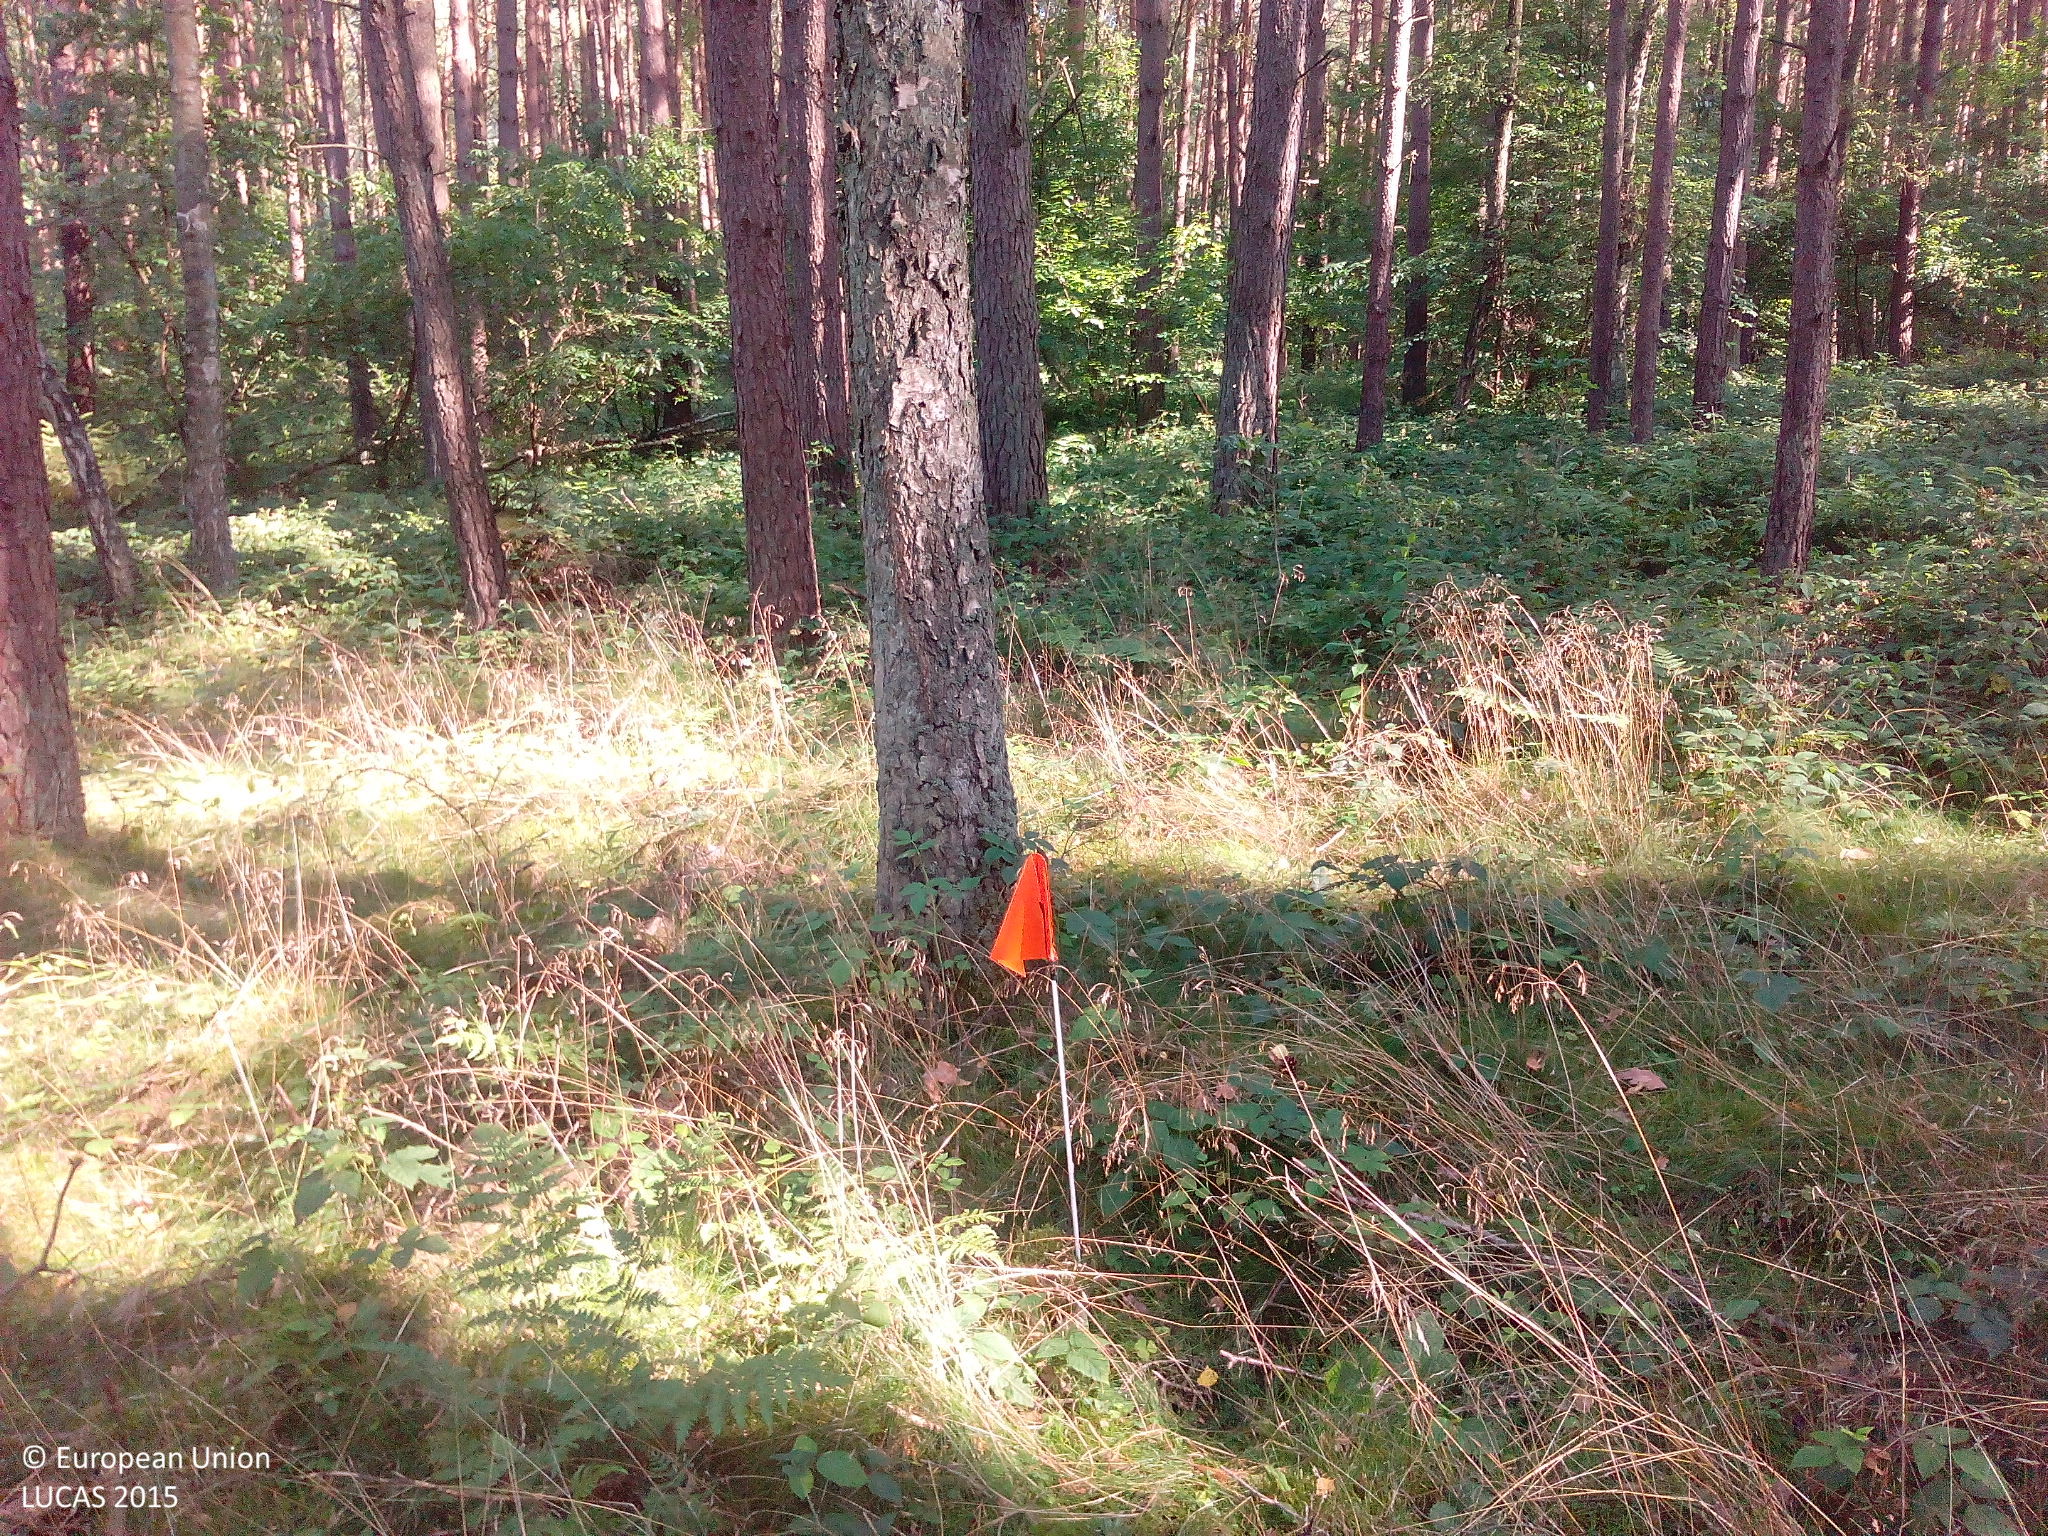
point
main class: Woodland
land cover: Pine dominated mixed woodland
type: hemiboreal forest and nemoral coniferous forest and mixed broadleaved-coniferous forest
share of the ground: > 75 %
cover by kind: coniferous forest trees 60 %, broadleaved forest trees 25 %, herbaceous plants 10 %, shrubs 5 %
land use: Forestry
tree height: > 5 m
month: August
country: DE
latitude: 53.5945
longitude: 12.3714
